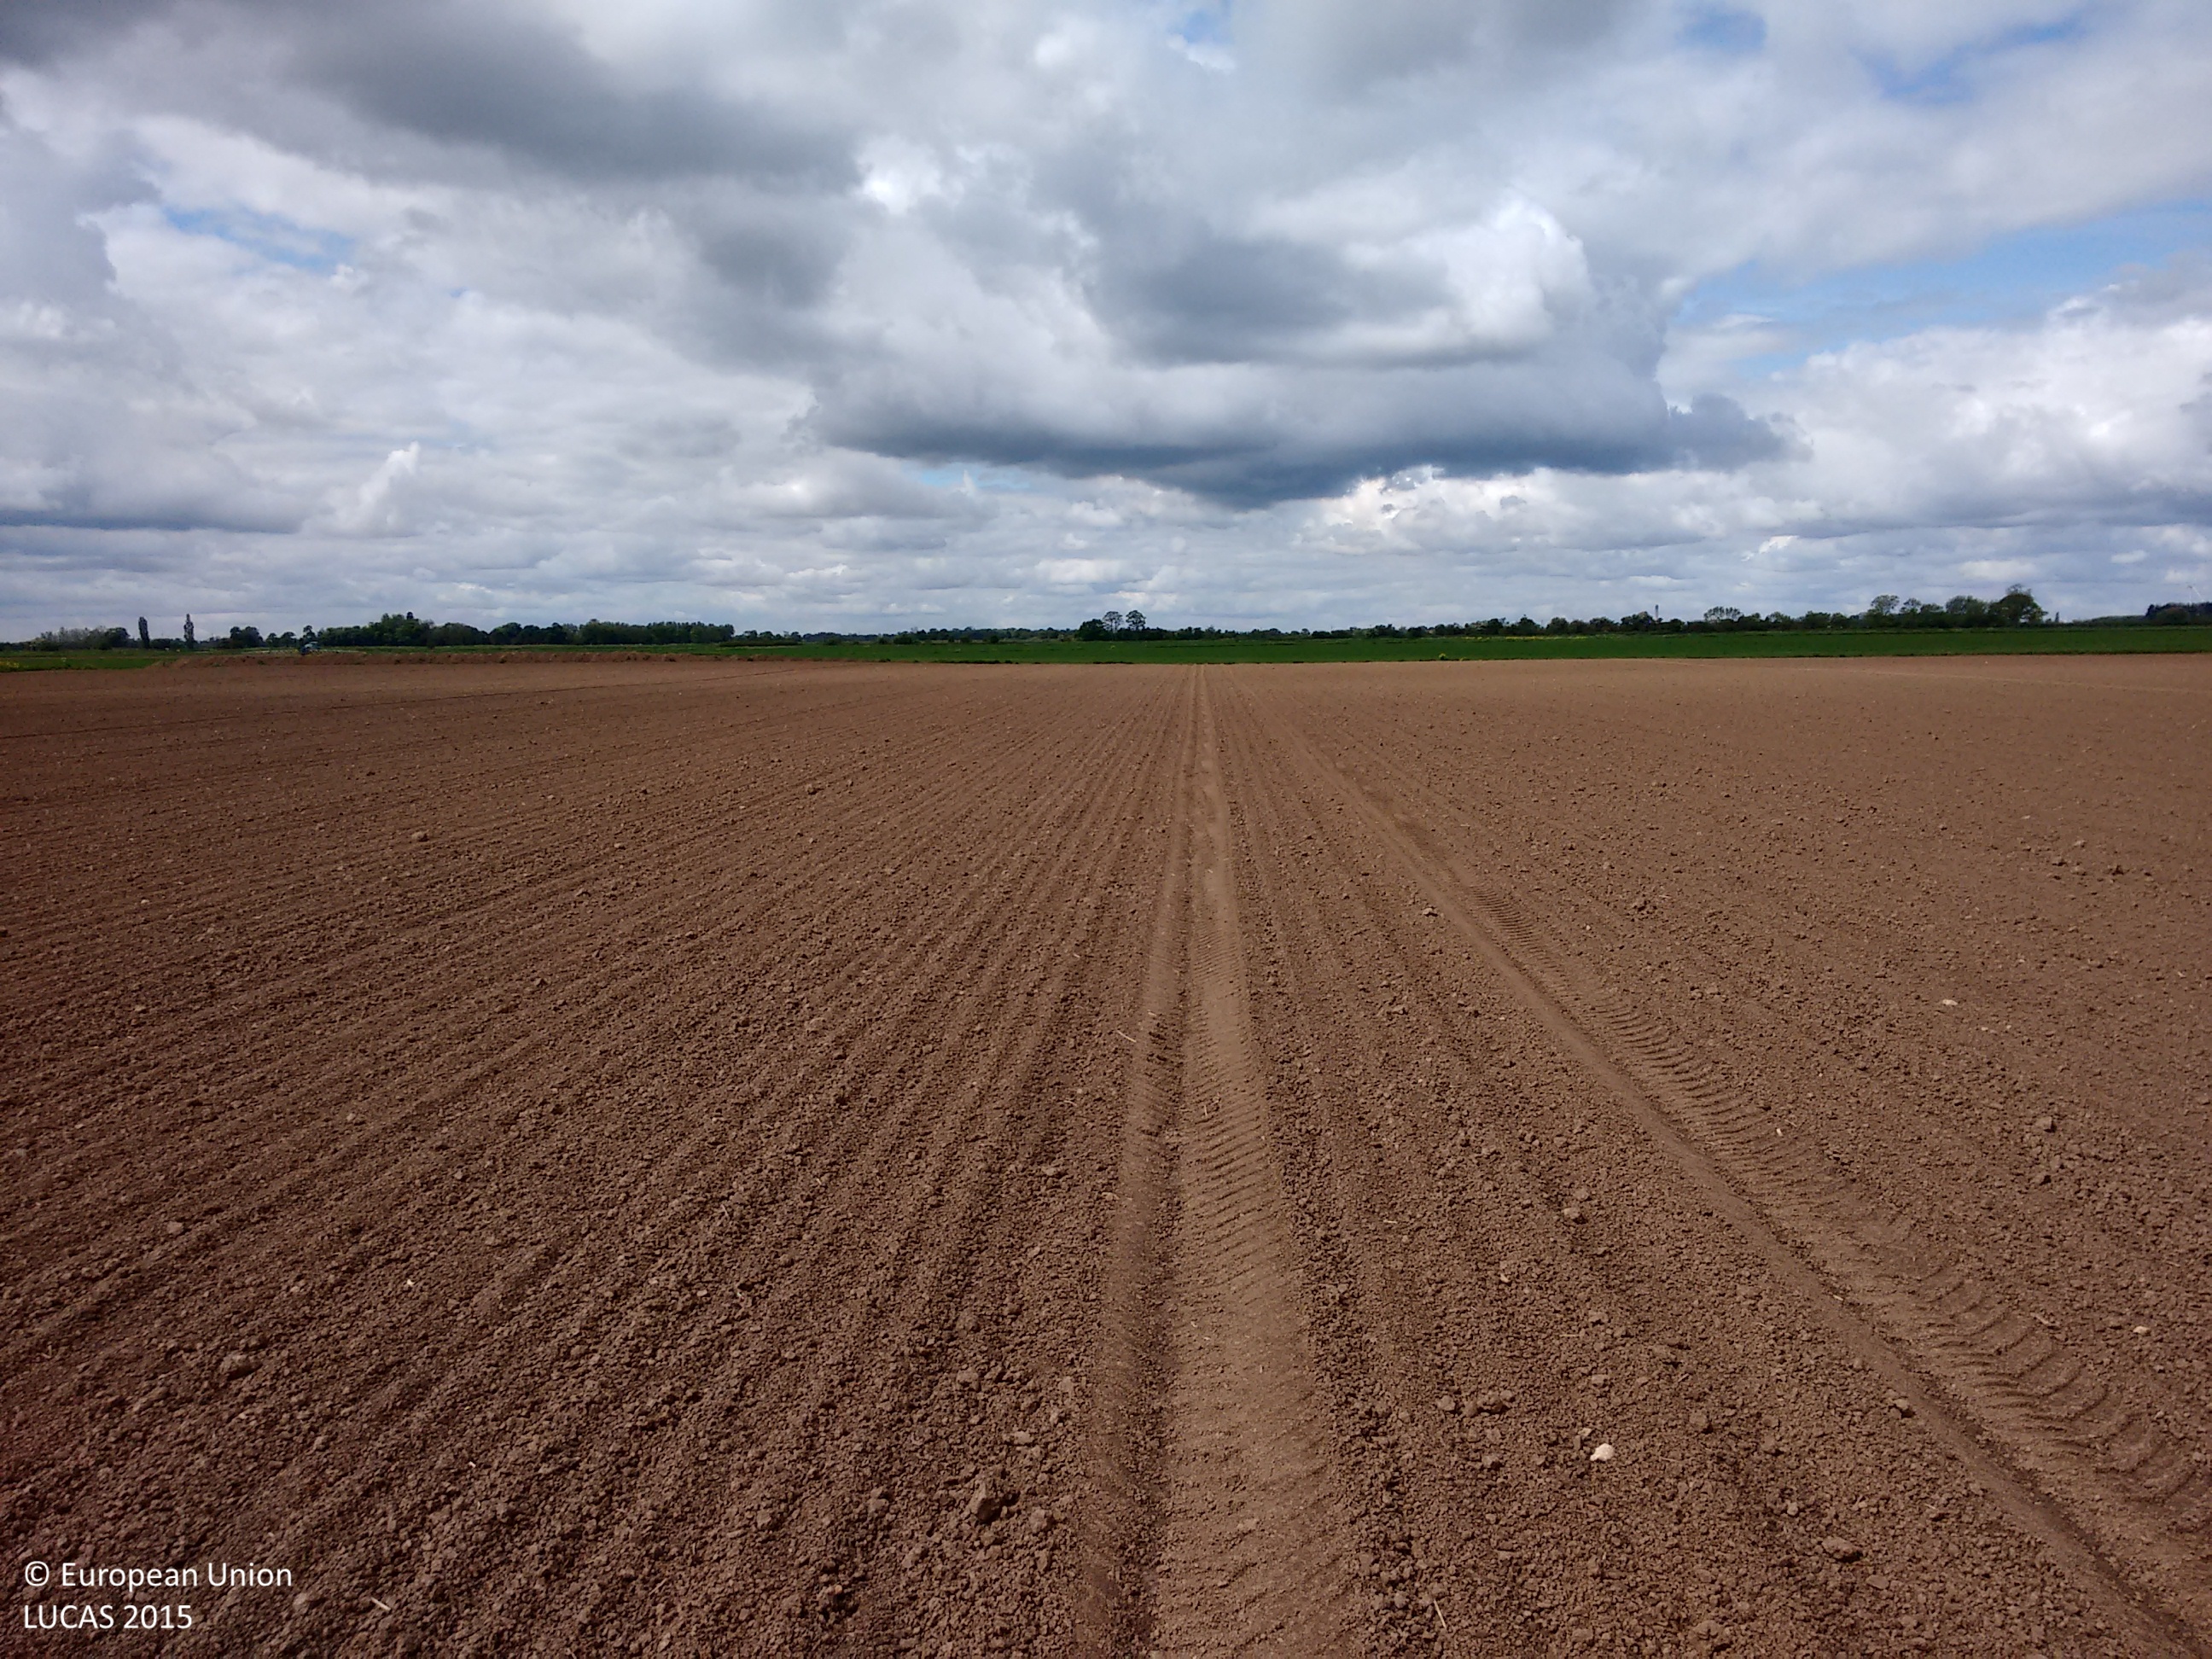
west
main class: Cropland
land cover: Dry pulses
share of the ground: > 75 %
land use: Agriculture (excluding fallow land and kitchen gardens)
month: May
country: GB
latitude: 53.7199
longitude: -0.7539
